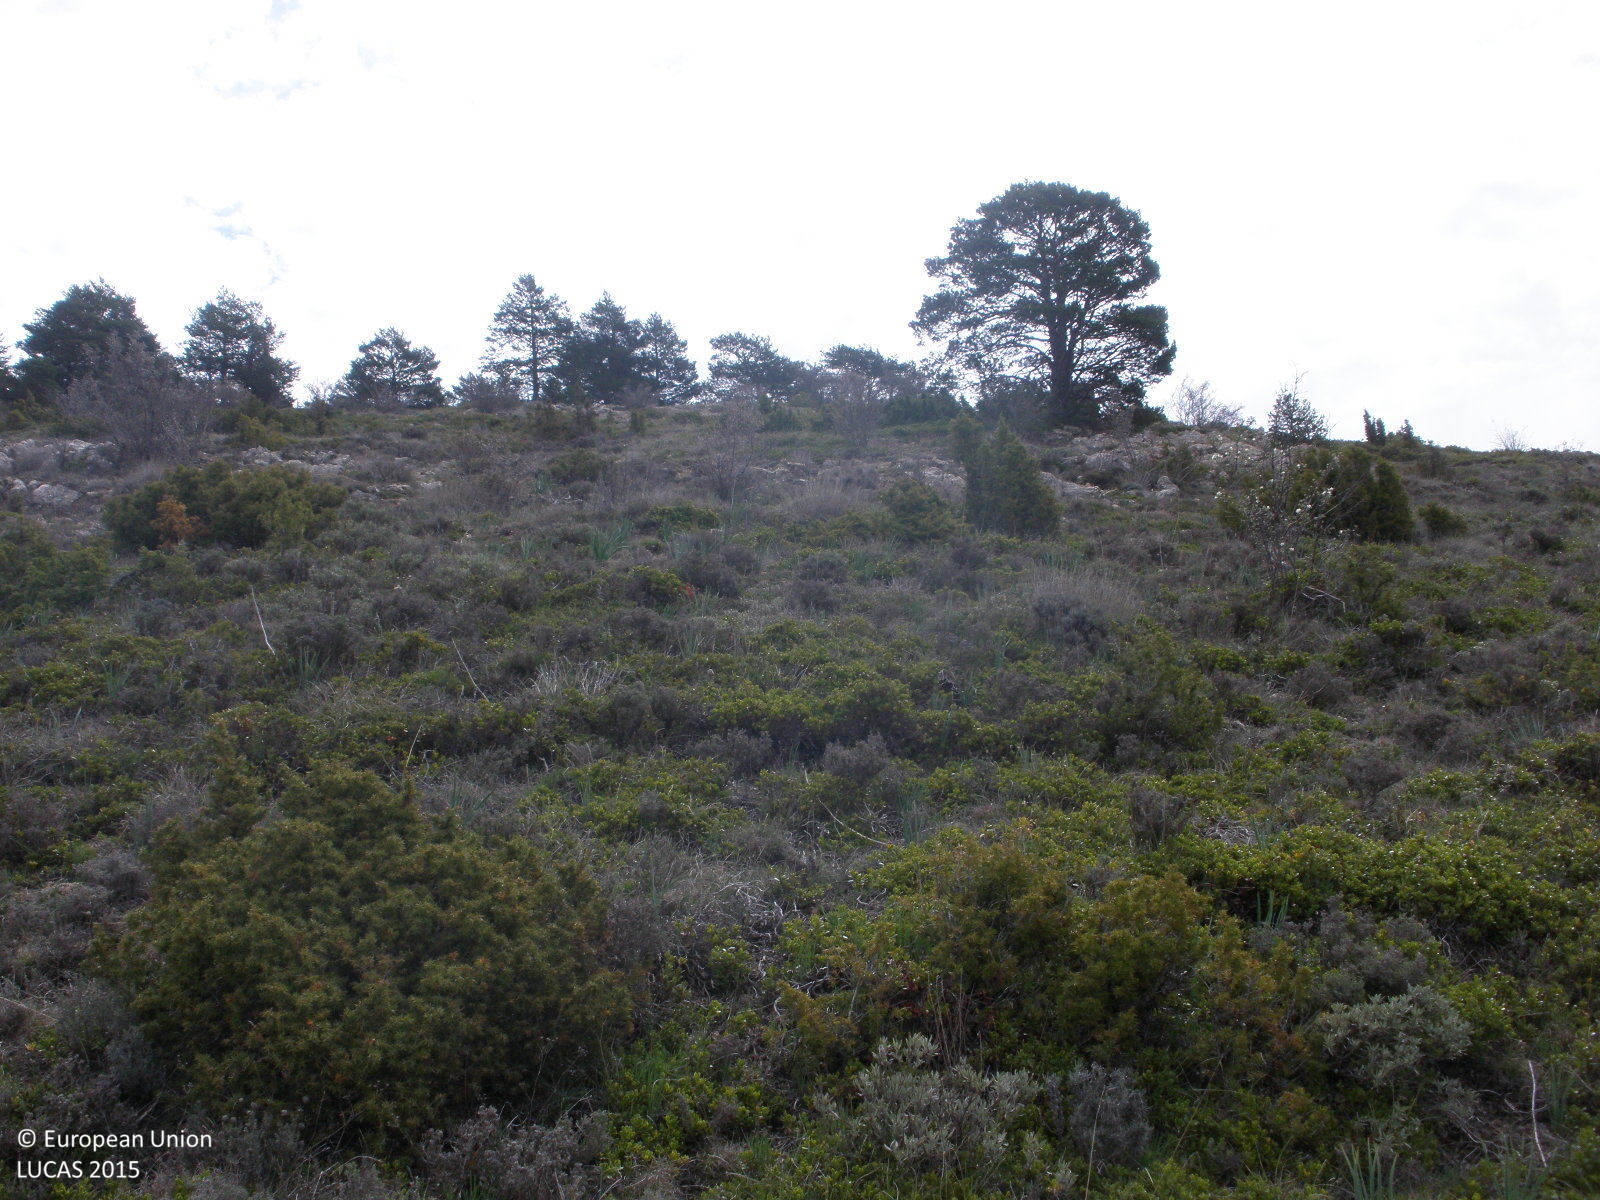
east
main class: Shrubland
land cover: Shrubland without tree cover
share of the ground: > 75 %
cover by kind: shrubs 75 %, herbaceous plants 15 %, consolidated bare surface 10 %
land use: Agriculture (excluding fallow land and kitchen gardens)
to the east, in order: Shrubland without tree cover; Pine dominated coniferous woodland; Rock outcrops; Shrubland without tree cover
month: May
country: ES
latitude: 40.4562
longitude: -0.7758
